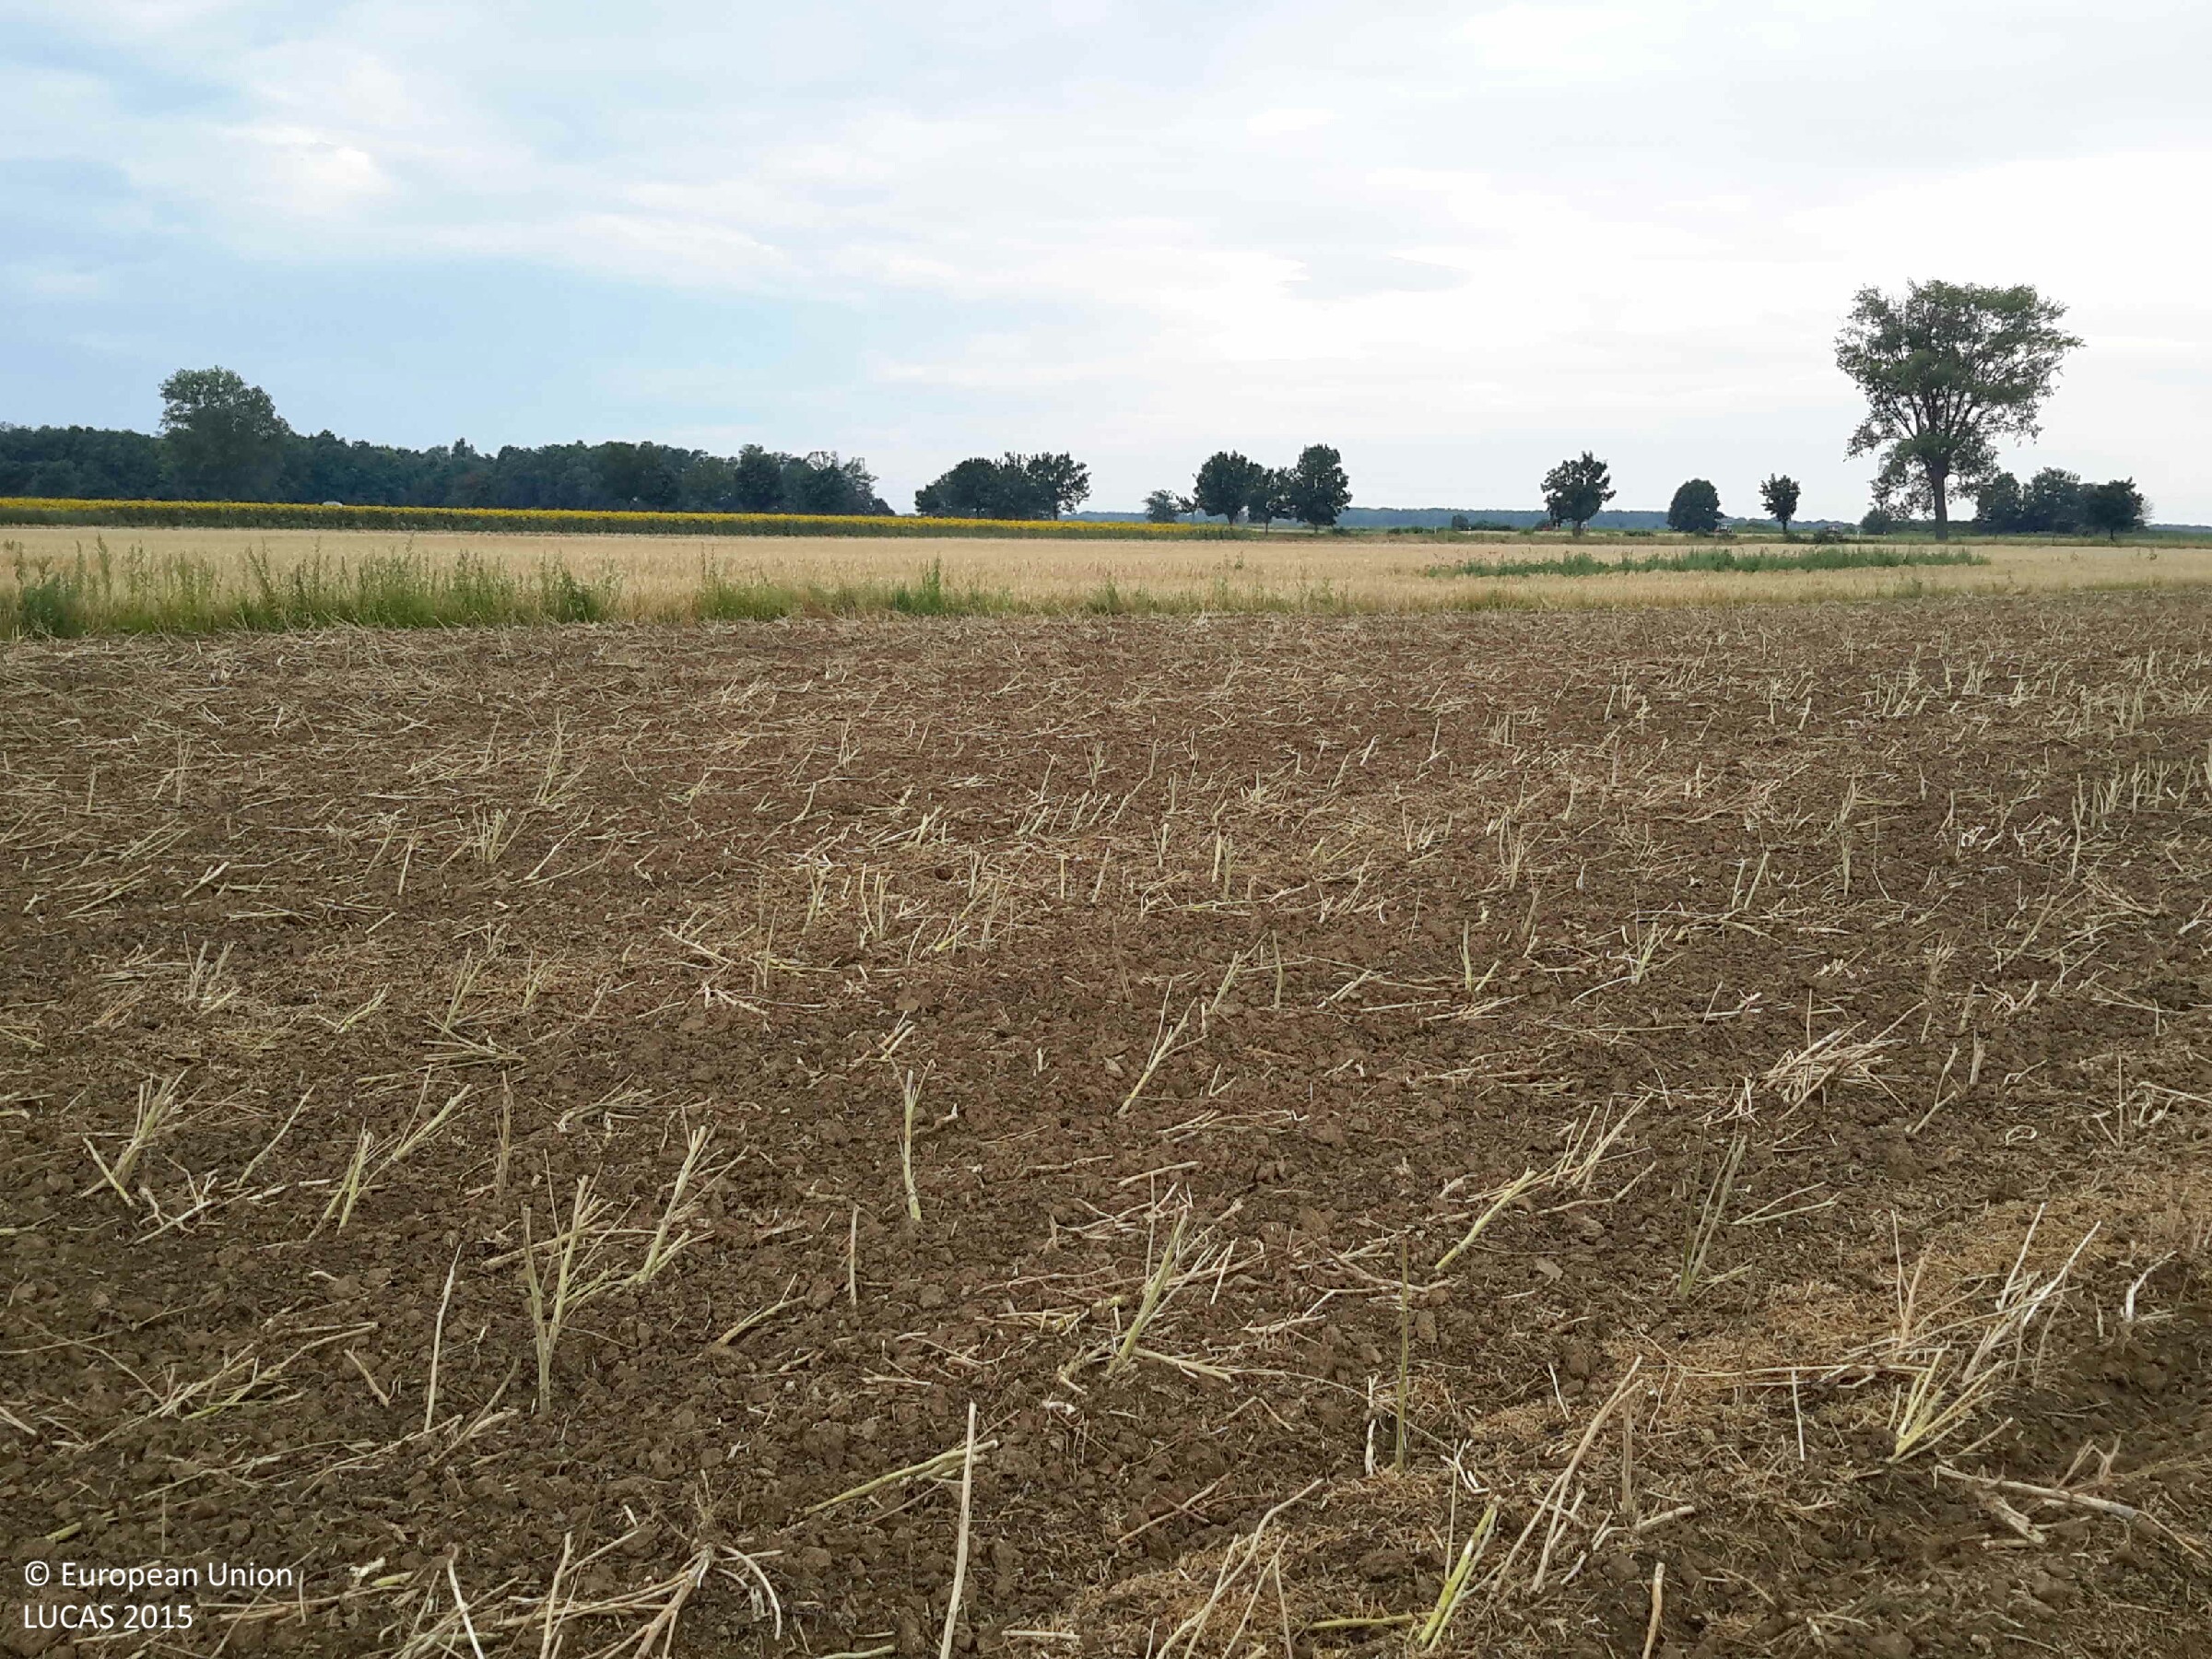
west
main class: Cropland
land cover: Common wheat
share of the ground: > 75 %
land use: Agriculture (excluding fallow land and kitchen gardens)
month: July
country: HU
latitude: 47.4362
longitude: 17.0730
